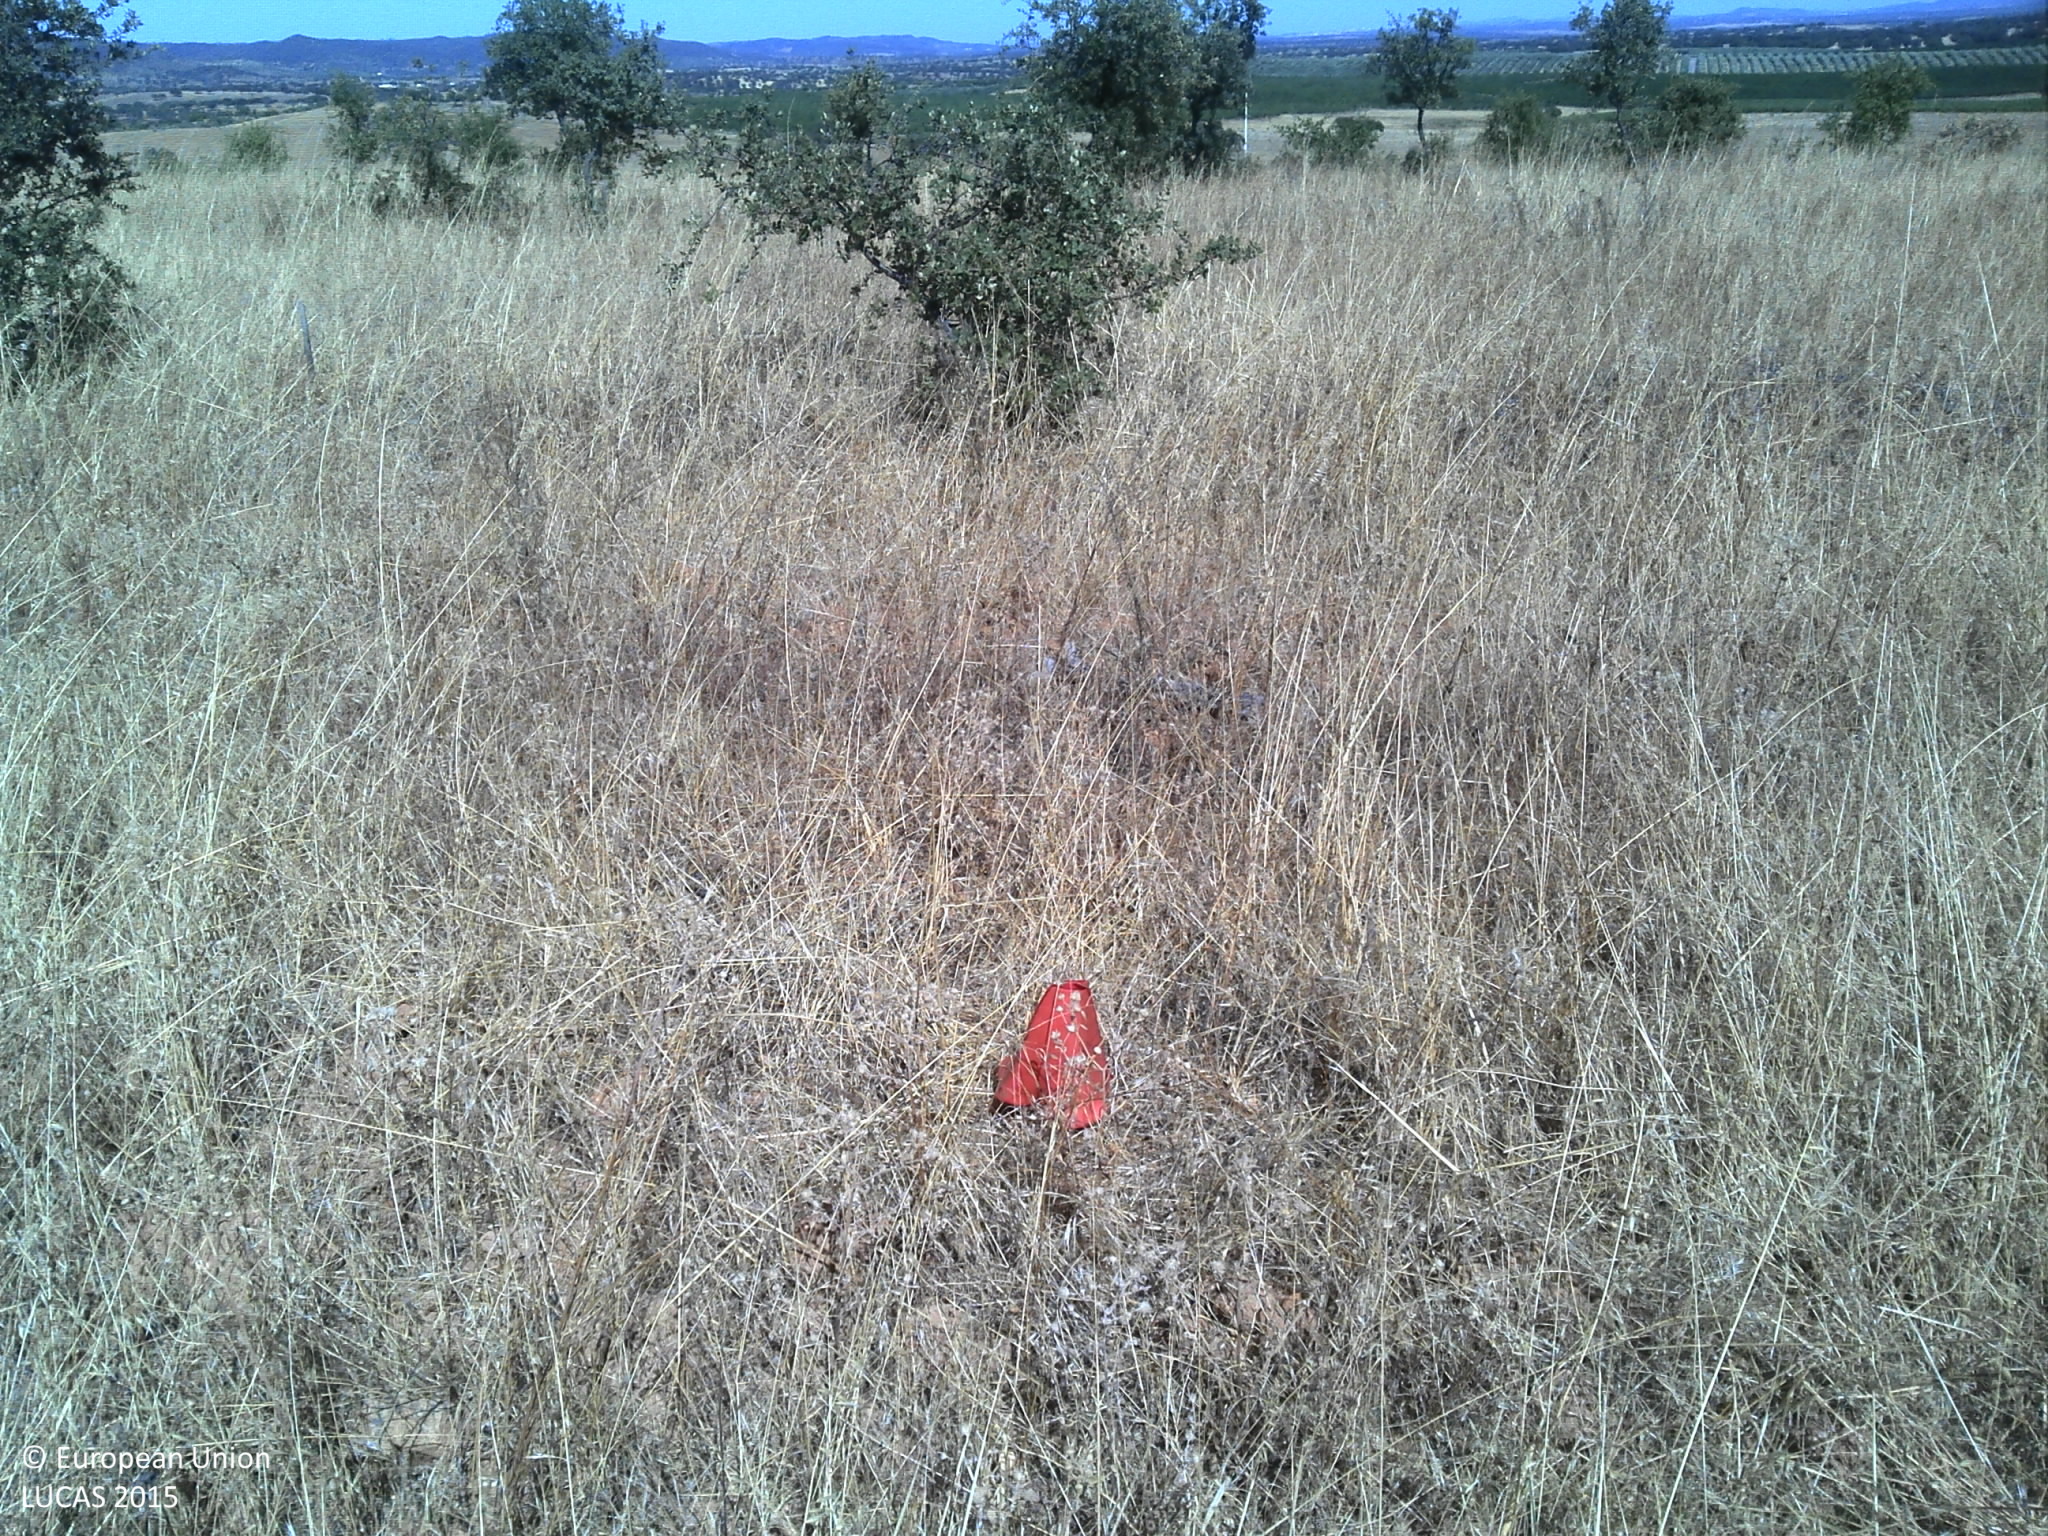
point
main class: Woodland
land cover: Broadleaved woodland
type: broadleaved evergreen forest
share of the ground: 25 - 50 %
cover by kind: broadleaved forest trees 40 %, unconsolidated bare surface 30 %, herbaceous plants 25 %, shrubs 5 %
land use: Forestry
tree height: < 5 m
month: July
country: PT
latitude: 38.1753
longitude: -7.7328
